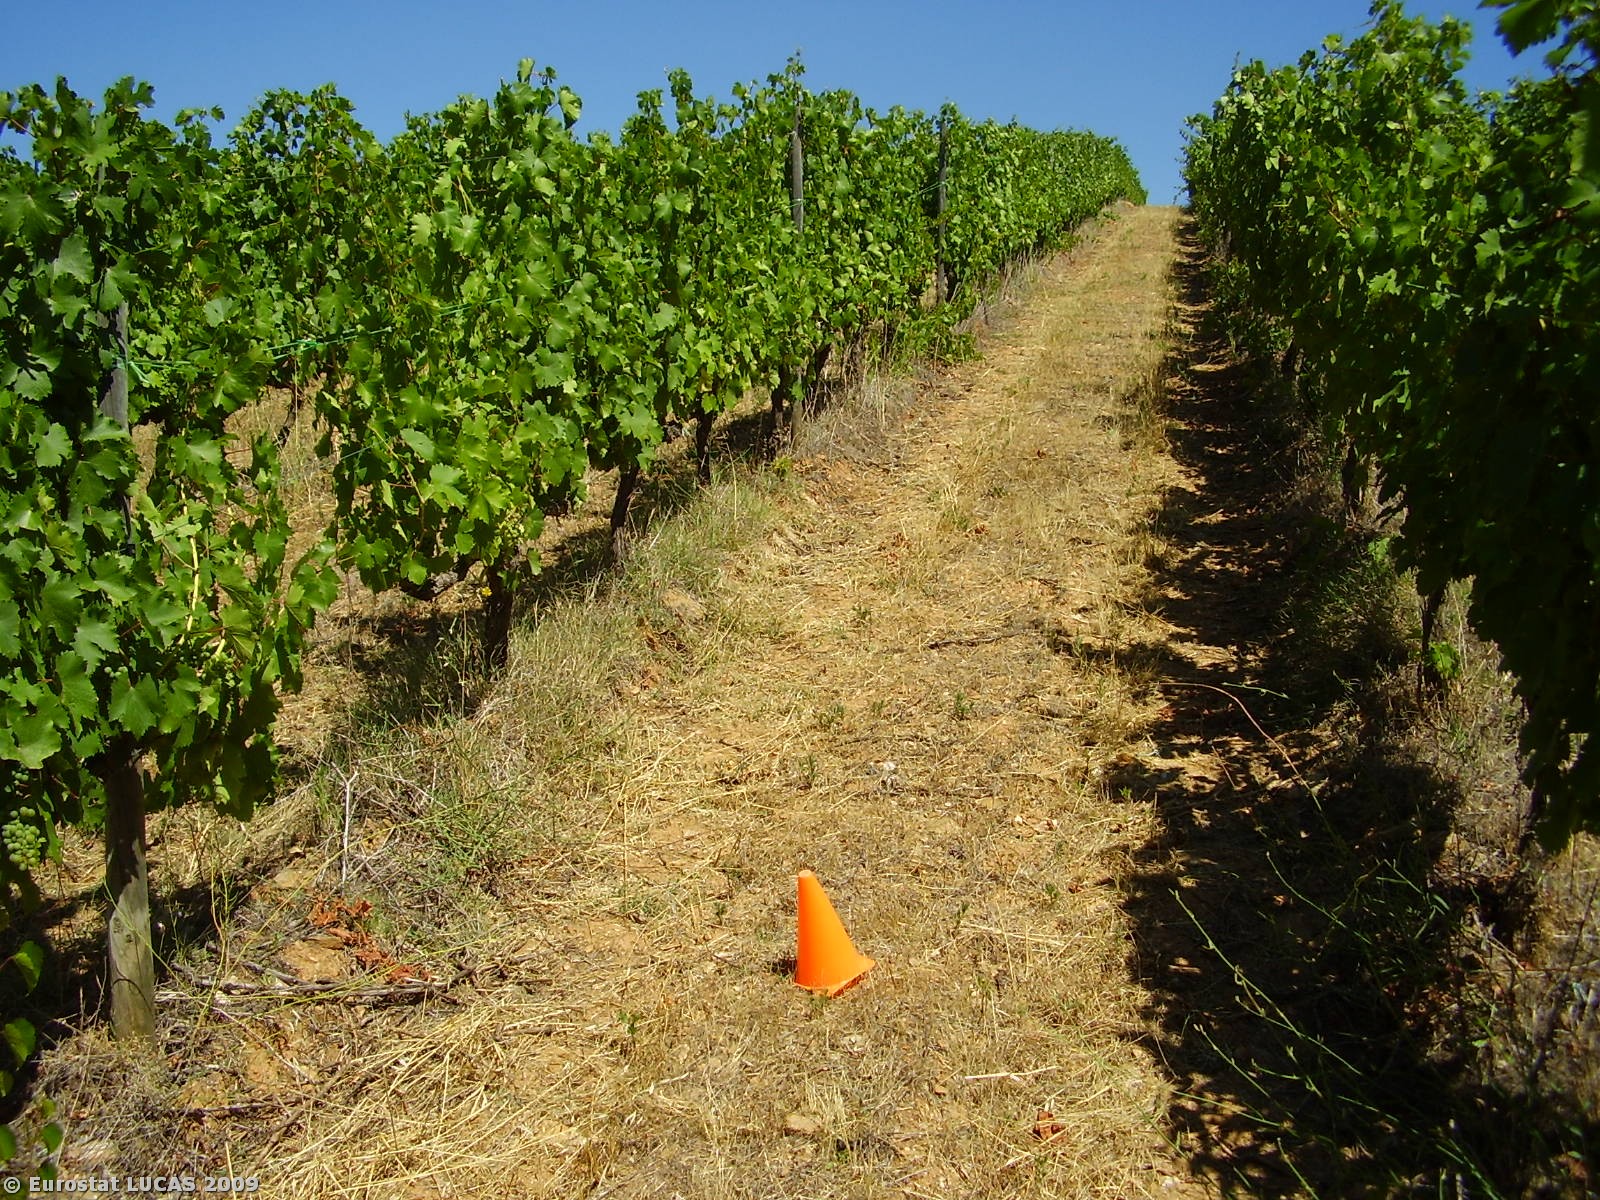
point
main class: Cropland
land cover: Vineyards
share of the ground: < 10 %
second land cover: Spontaneously vegetated surfaces
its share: > 75 %
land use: Agriculture (excluding fallow land and kitchen gardens)
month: July
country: PT
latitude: 41.6010
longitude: -7.3666
